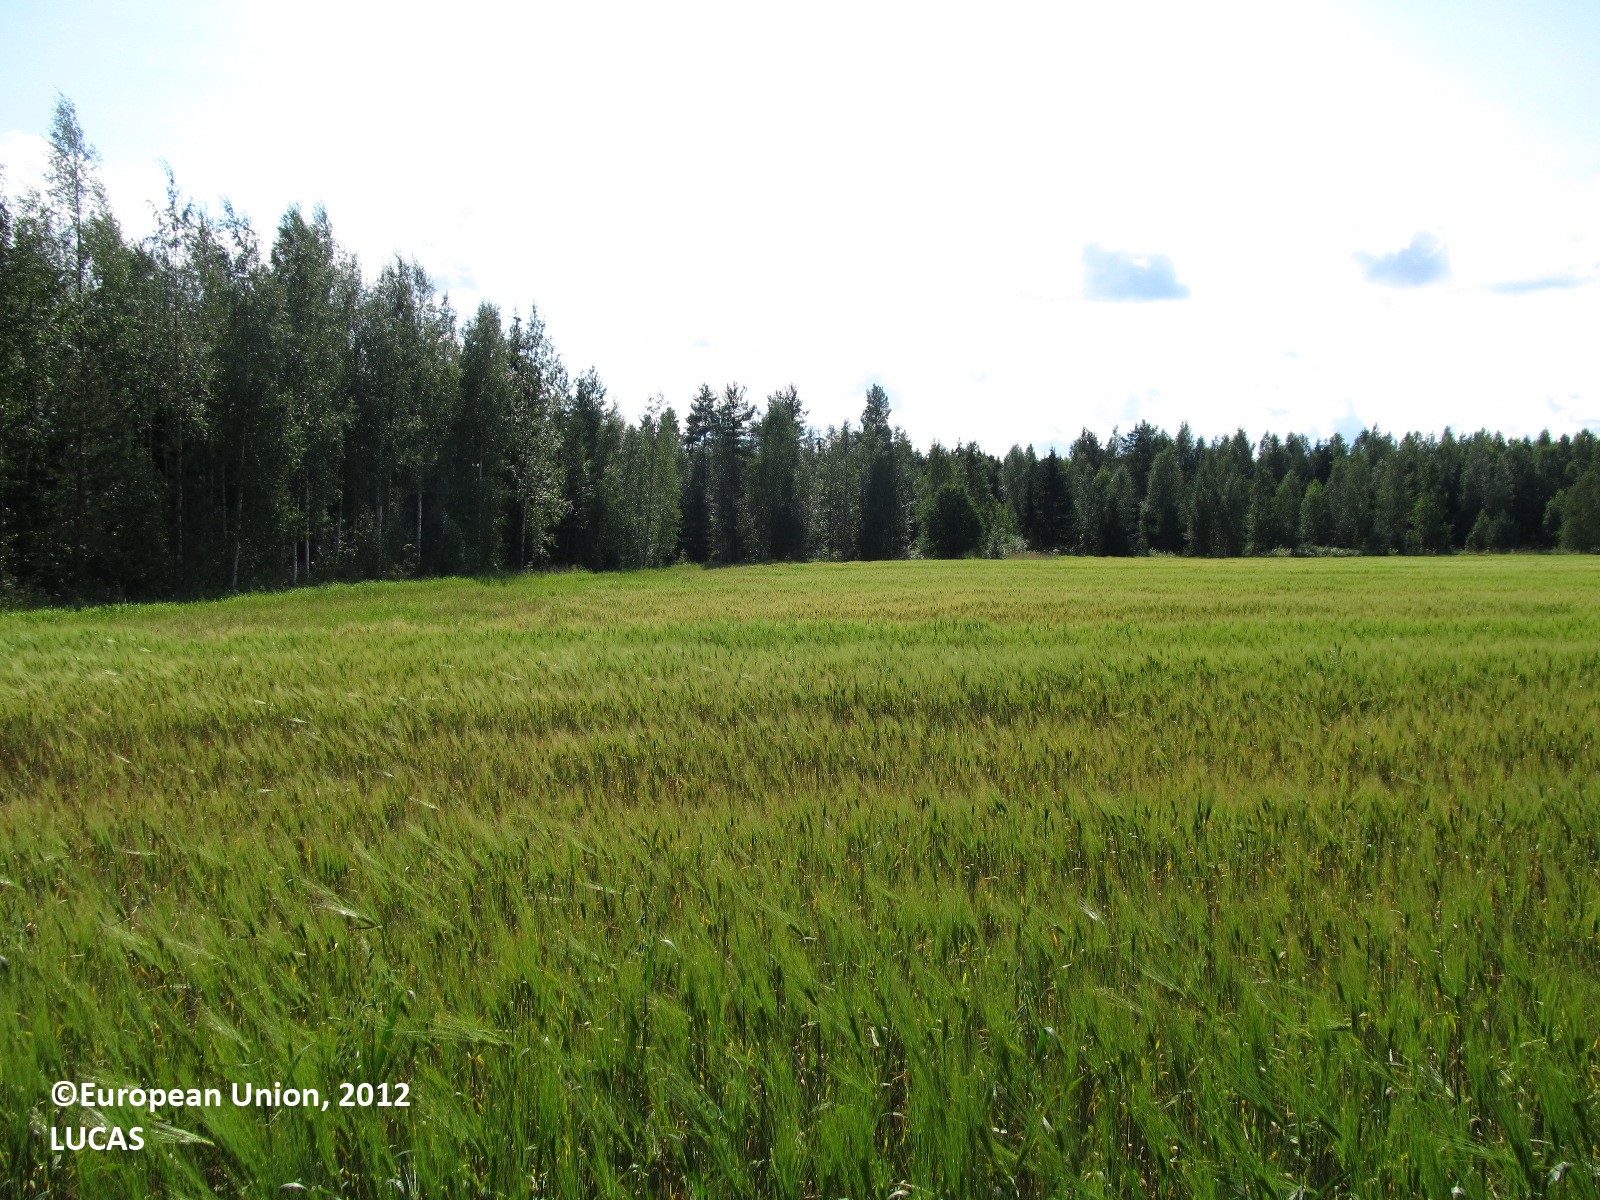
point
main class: Cropland
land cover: Barley
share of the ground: 50 - 75 %
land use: Agriculture (excluding fallow land and kitchen gardens)
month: July
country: FI
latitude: 62.0950
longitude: 28.1000
